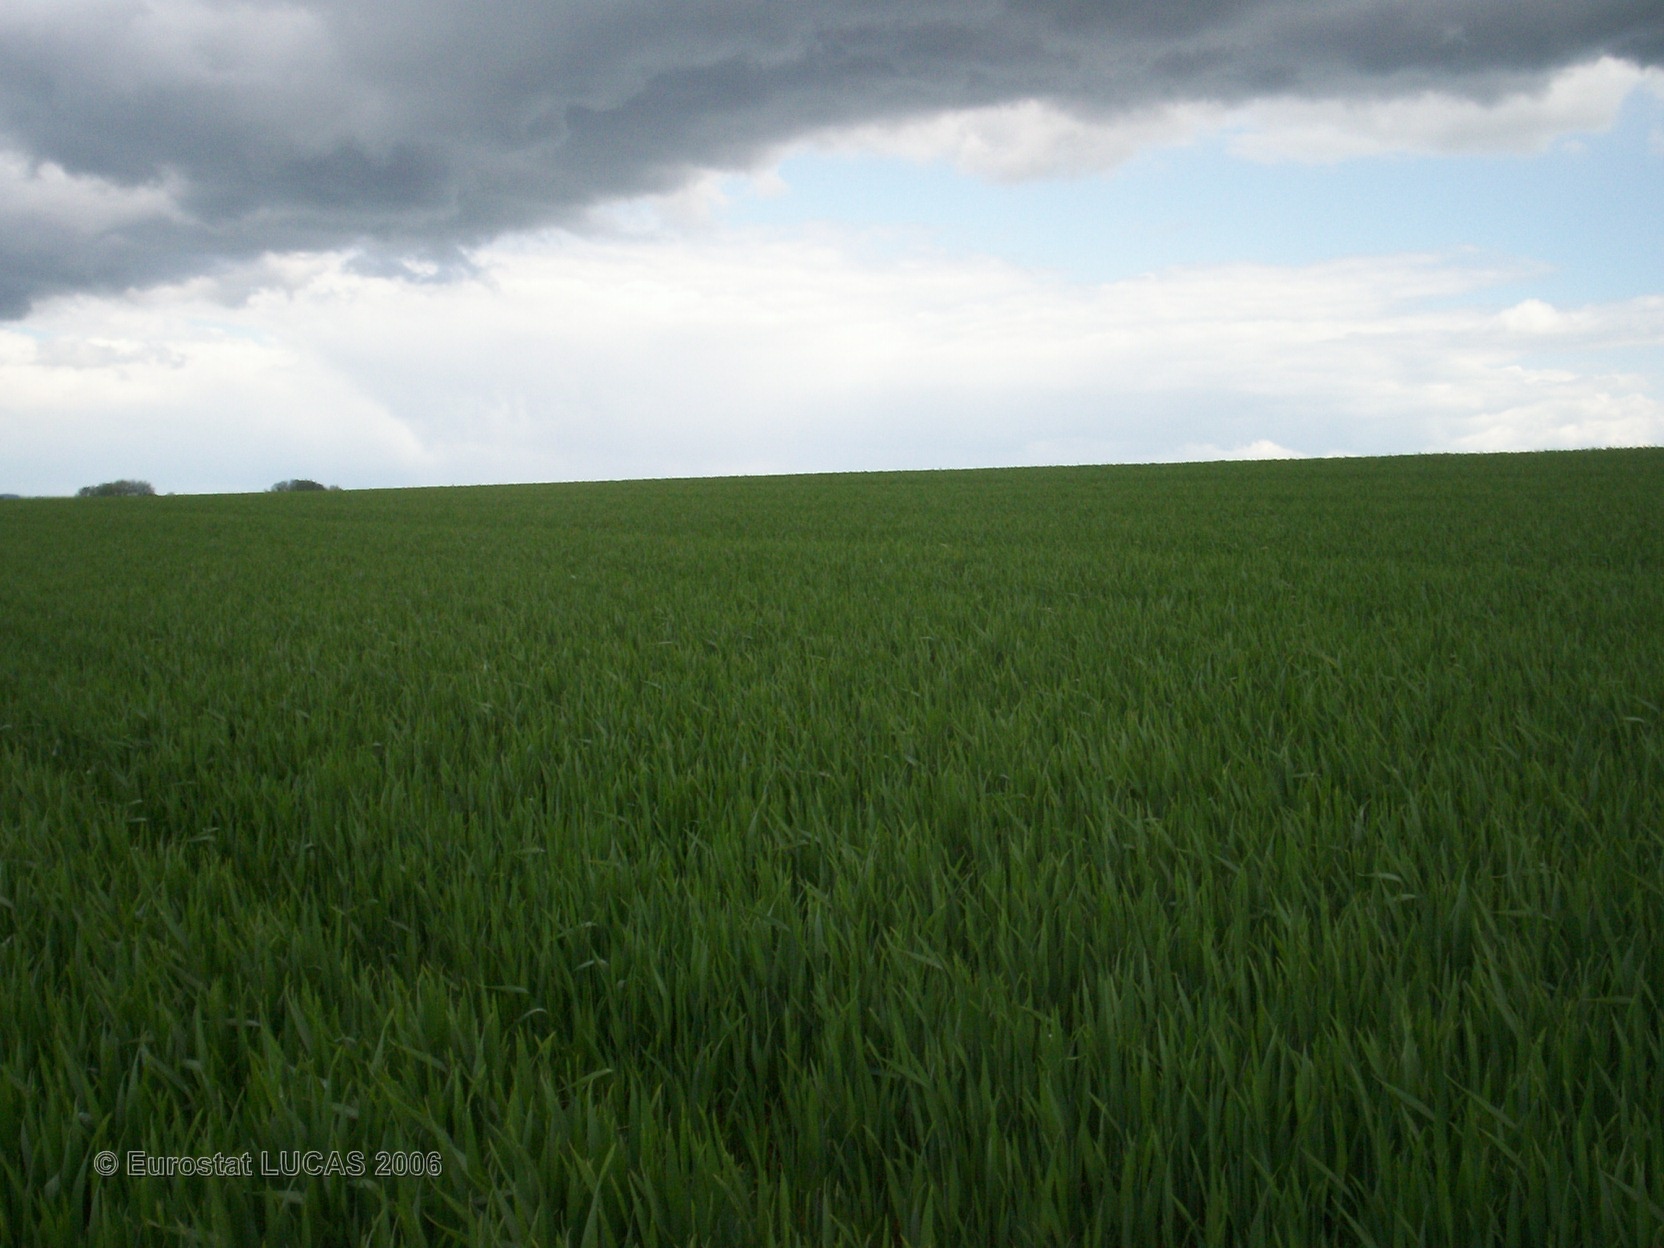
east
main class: Cropland
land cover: Common wheat
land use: Agriculture (excluding fallow land and kitchen gardens)
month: May
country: FR
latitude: 49.4424
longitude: 4.5764
